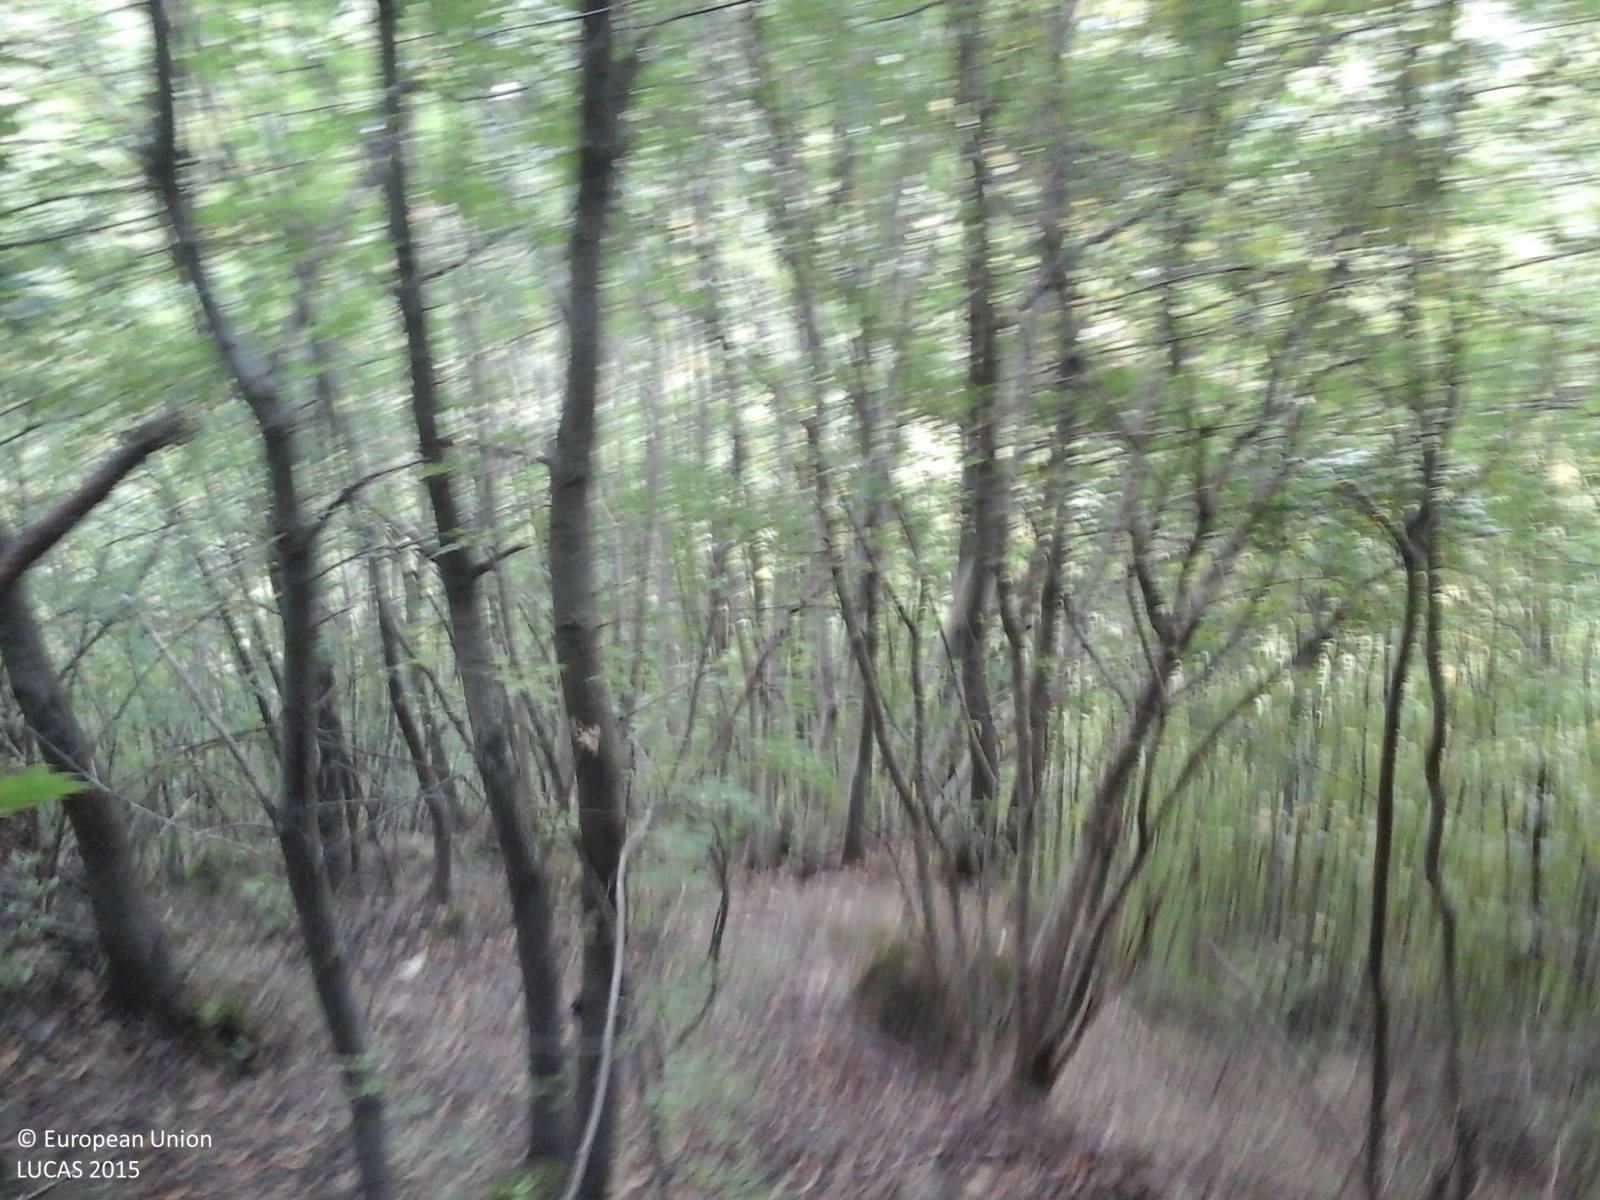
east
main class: Woodland
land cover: Broadleaved woodland
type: thermophilous deciduous forest
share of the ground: > 75 %
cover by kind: broadleaved forest trees 100 %
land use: Forestry
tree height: > 5 m
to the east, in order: Broadleaved woodland; Tracks; Broadleaved woodland; Rivers and streams; Broadleaved woodland
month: October
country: IT
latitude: 42.7268
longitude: 13.2998
